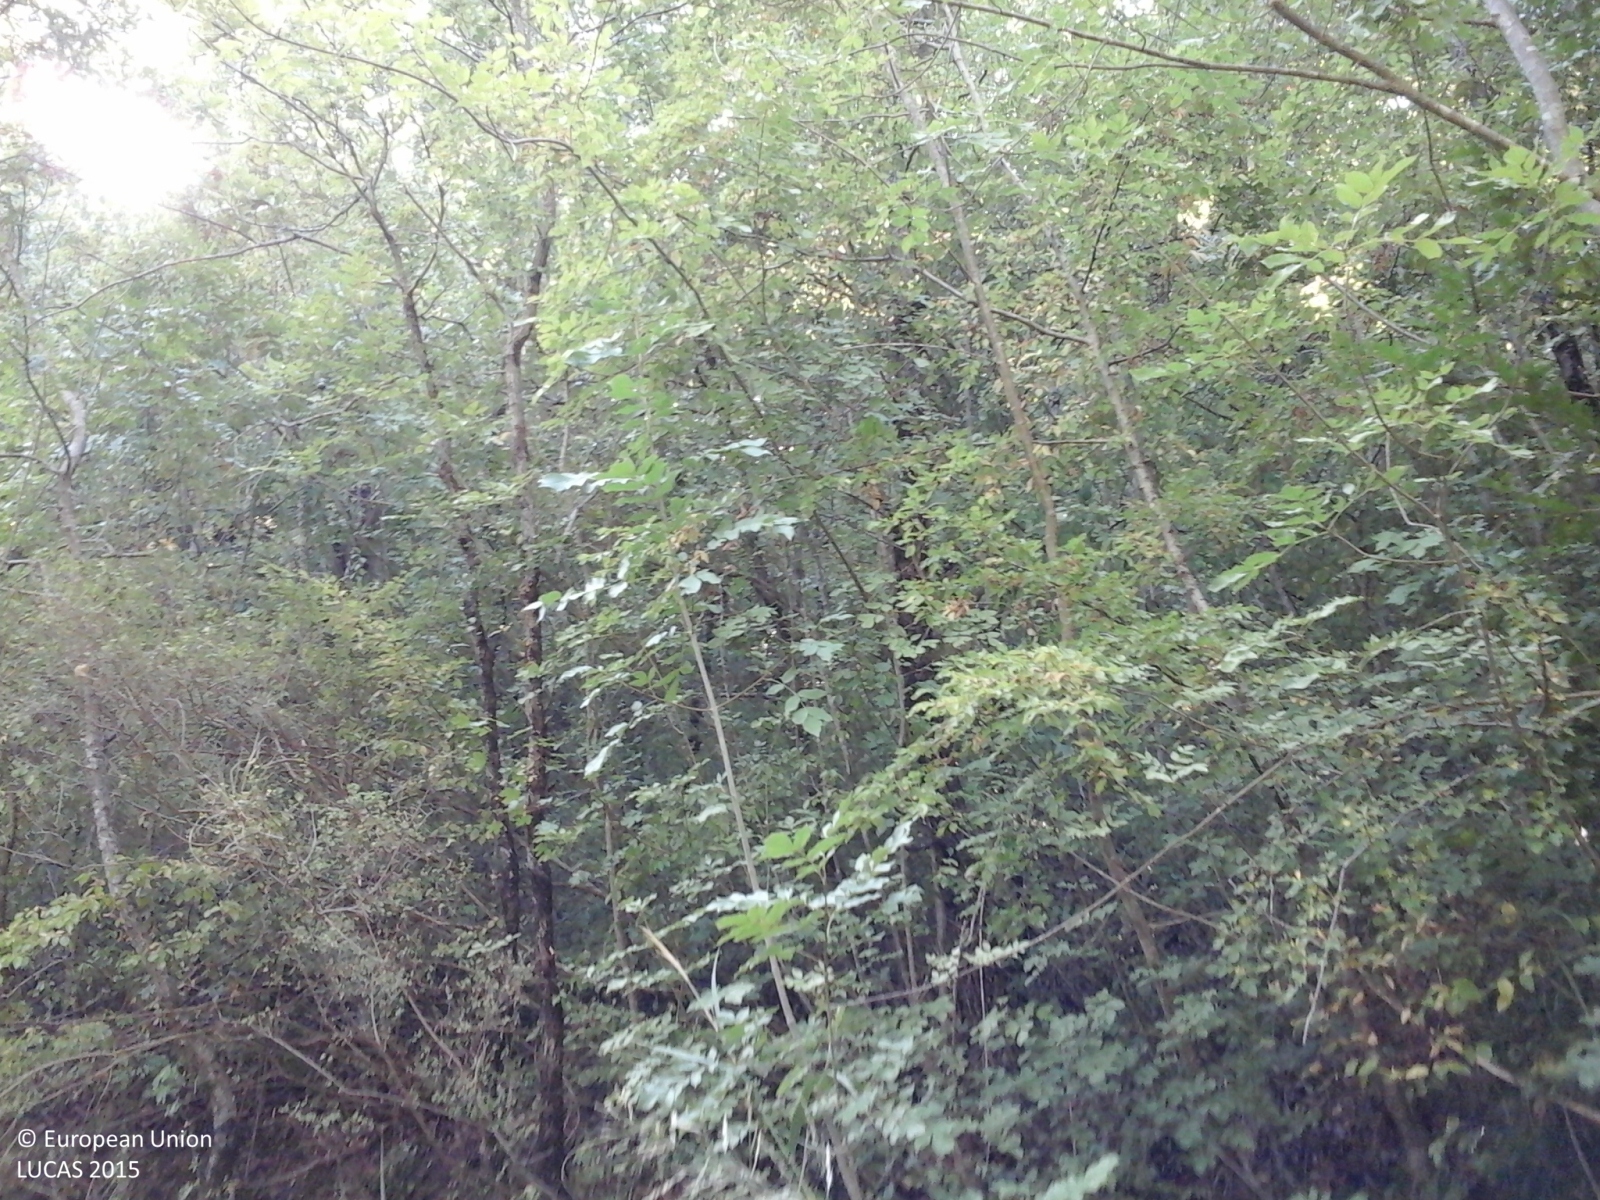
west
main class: Woodland
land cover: Broadleaved woodland
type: thermophilous deciduous forest
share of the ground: > 75 %
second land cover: Grassland without tree/shrub cover
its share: > 75 %
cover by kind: broadleaved forest trees 85 %, shrubs 10 %, herbaceous plants 5 %
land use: Forestry
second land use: Agriculture (excluding fallow land and kitchen gardens)
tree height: > 5 m
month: September
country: IT
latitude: 41.6454
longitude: 14.1753
